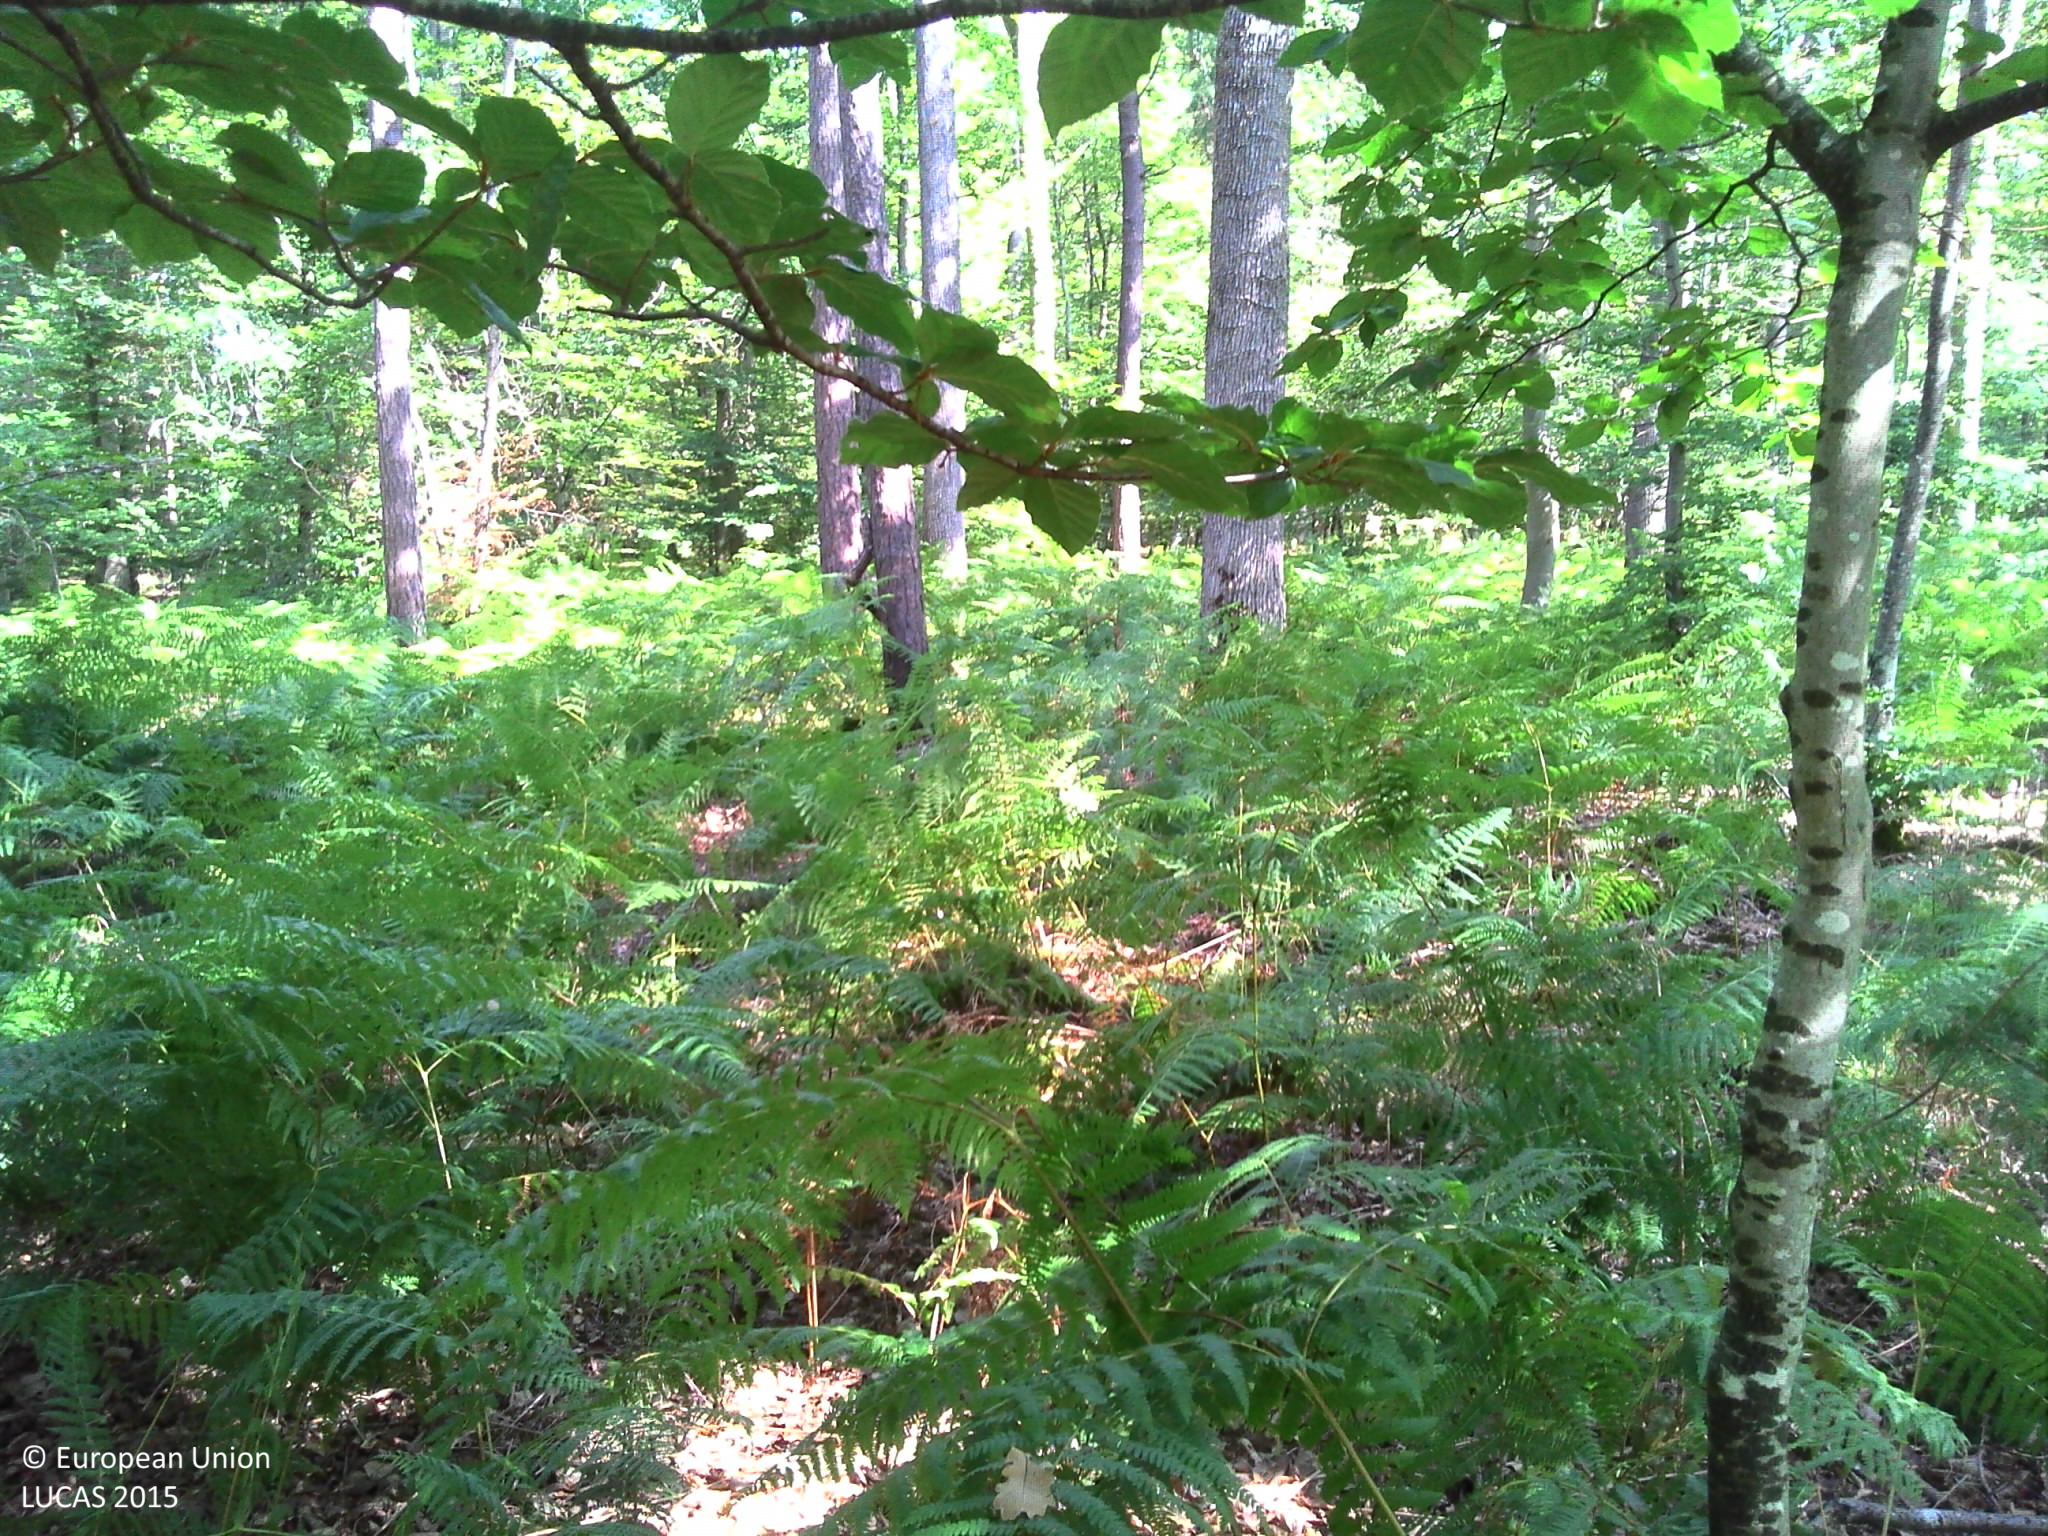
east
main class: Woodland
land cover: Broadleaved woodland
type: beech forest
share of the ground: > 75 %
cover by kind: broadleaved forest trees 75 %, herbaceous plants 10 %, lichens and mosses 10 %, coniferous forest trees 5 %
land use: Forestry
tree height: > 5 m
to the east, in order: Broadleaved woodland; Tracks; Broadleaved woodland; Grassland without tree/shrub cover; Ditches and canals; Grass margins; Paved roads, cycling and walking lanes
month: September
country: FR
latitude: 48.3832
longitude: 2.7670
